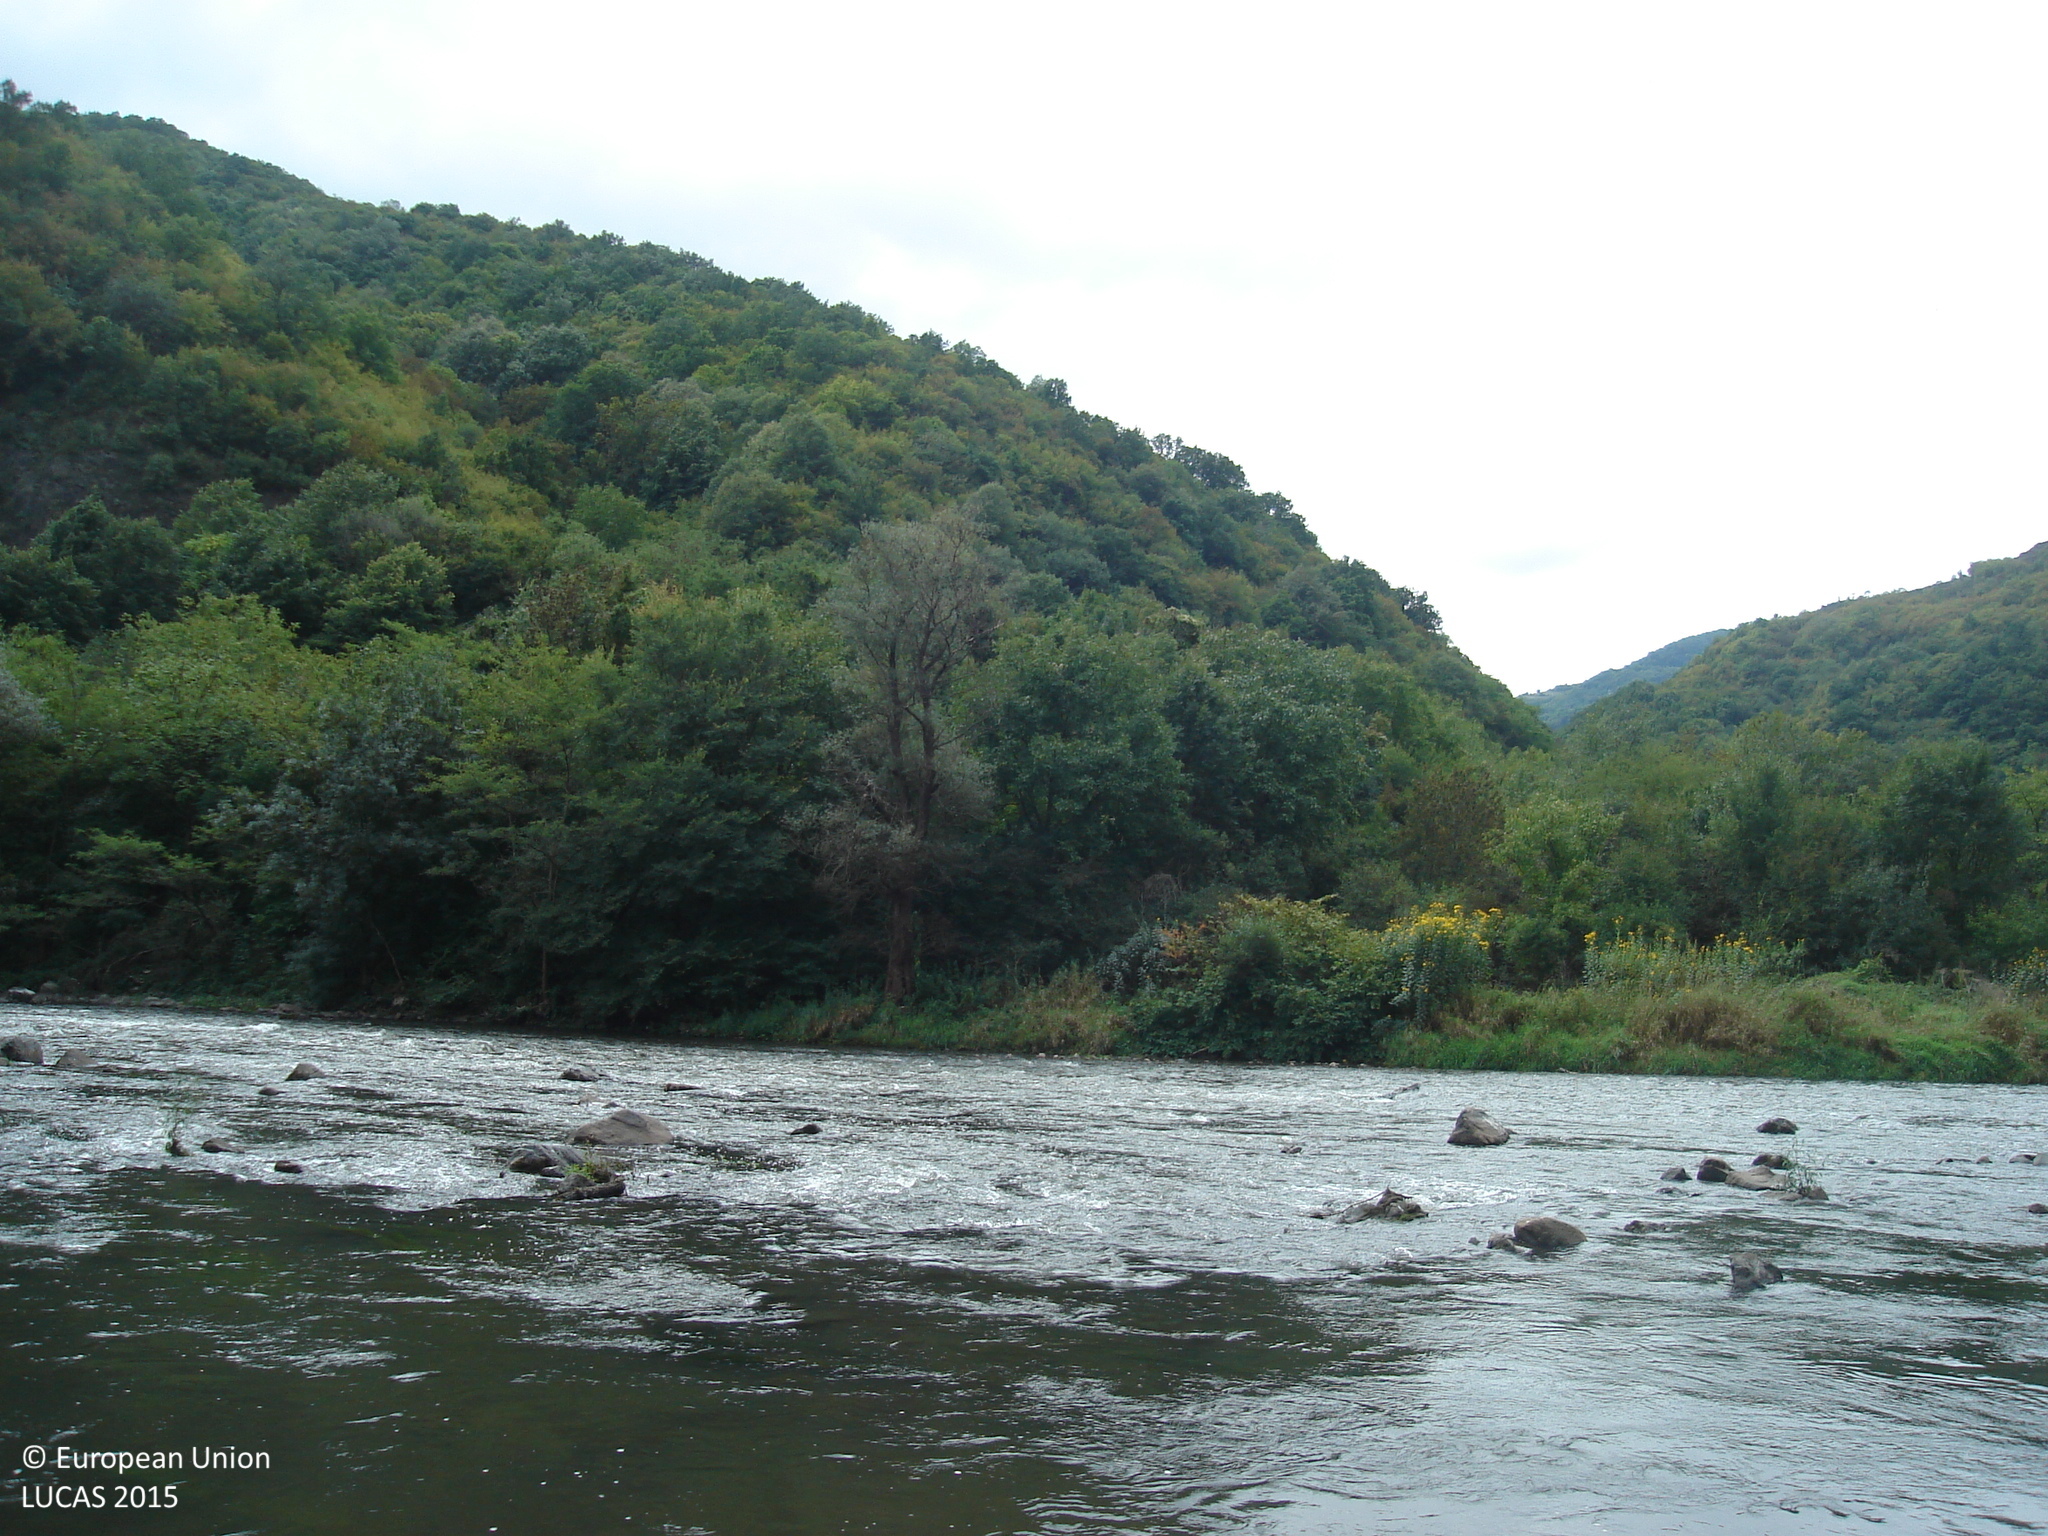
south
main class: Woodland
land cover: Broadleaved woodland
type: mesophytic deciduous forest
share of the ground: 50 - 75 %
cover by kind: broadleaved forest trees 70 %, unconsolidated bare surface 30 %
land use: Forestry
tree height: > 5 m
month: September
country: BG
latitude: 43.0442
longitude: 23.3571
